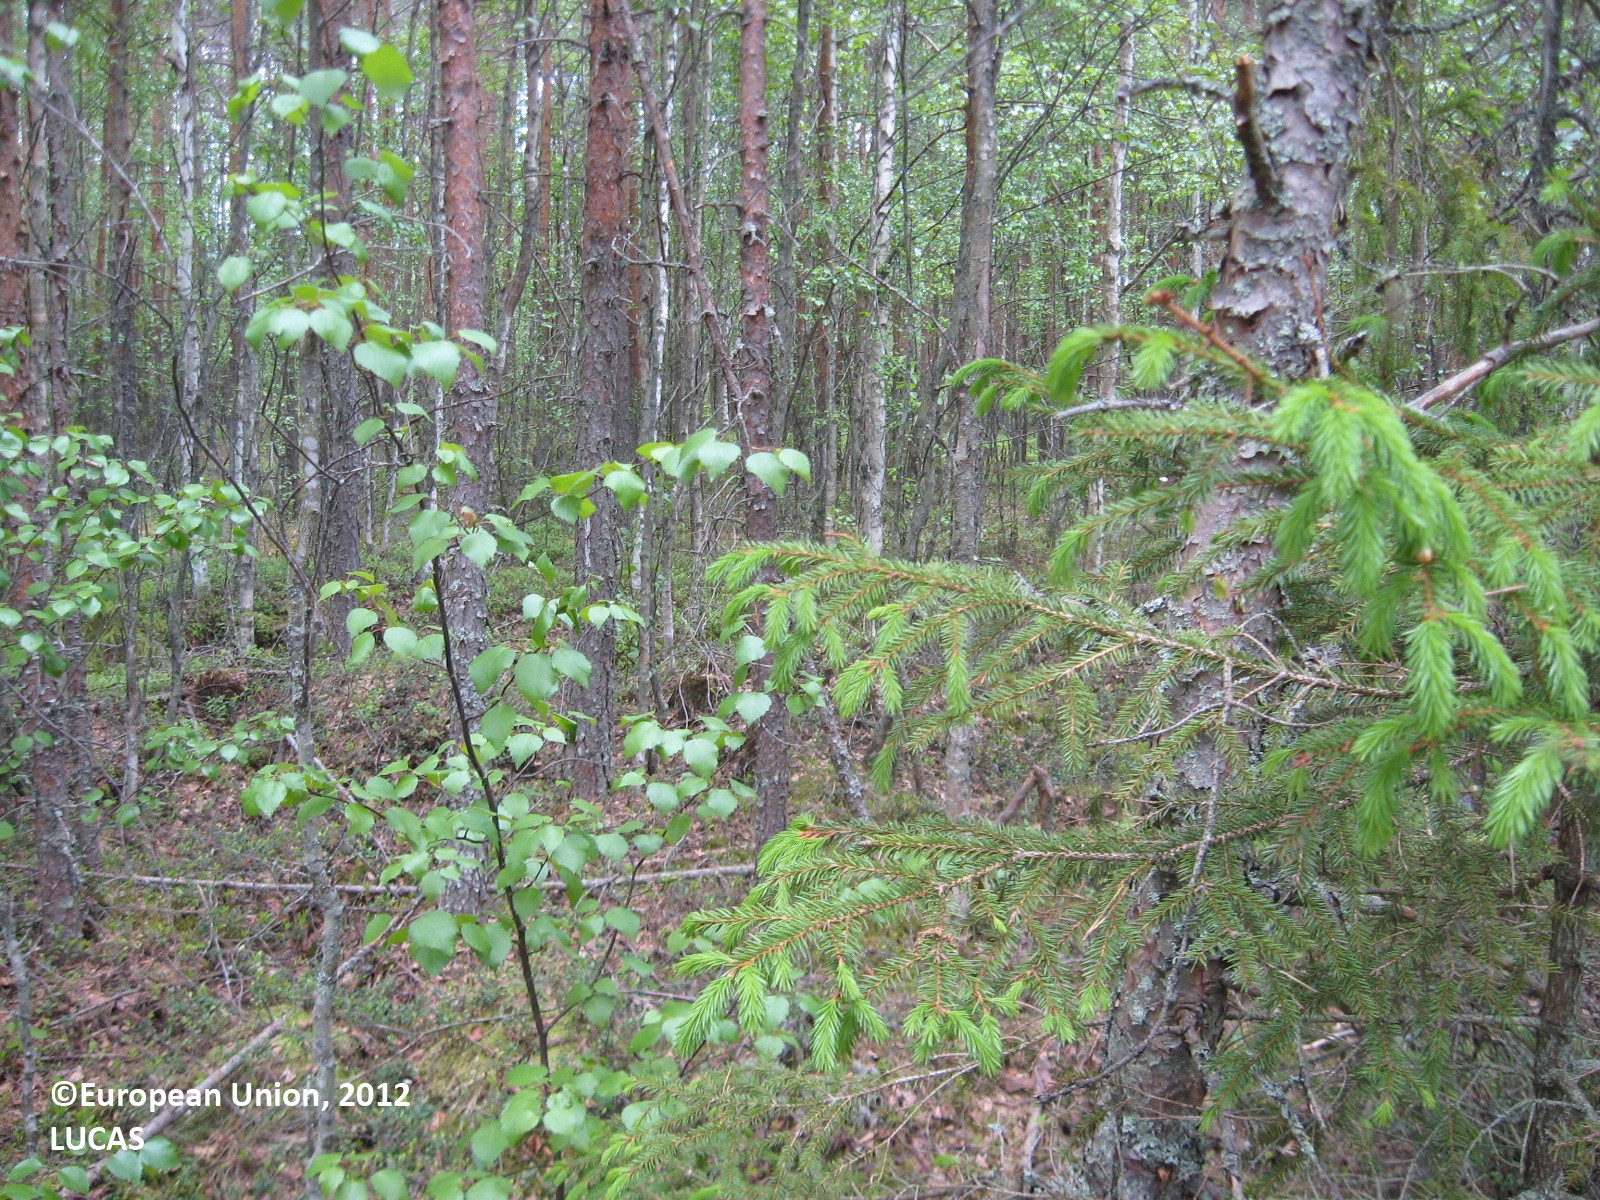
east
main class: Woodland
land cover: Pine dominated mixed woodland
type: boreal forest
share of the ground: > 75 %
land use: Forestry
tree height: > 5 m
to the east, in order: Pine dominated mixed woodland; Ditches and canals; Pine dominated mixed woodland; Ditches and canals; Pine dominated mixed woodland; Ditches and canals; Pine dominated mixed woodland; Ditches and canals; Pine dominated mixed woodland; Ditches and canals; Pine dominated coniferous woodland; Ditches and canals; Pine dominated coniferous woodland
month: June
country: FI
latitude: 63.1672
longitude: 22.7423
